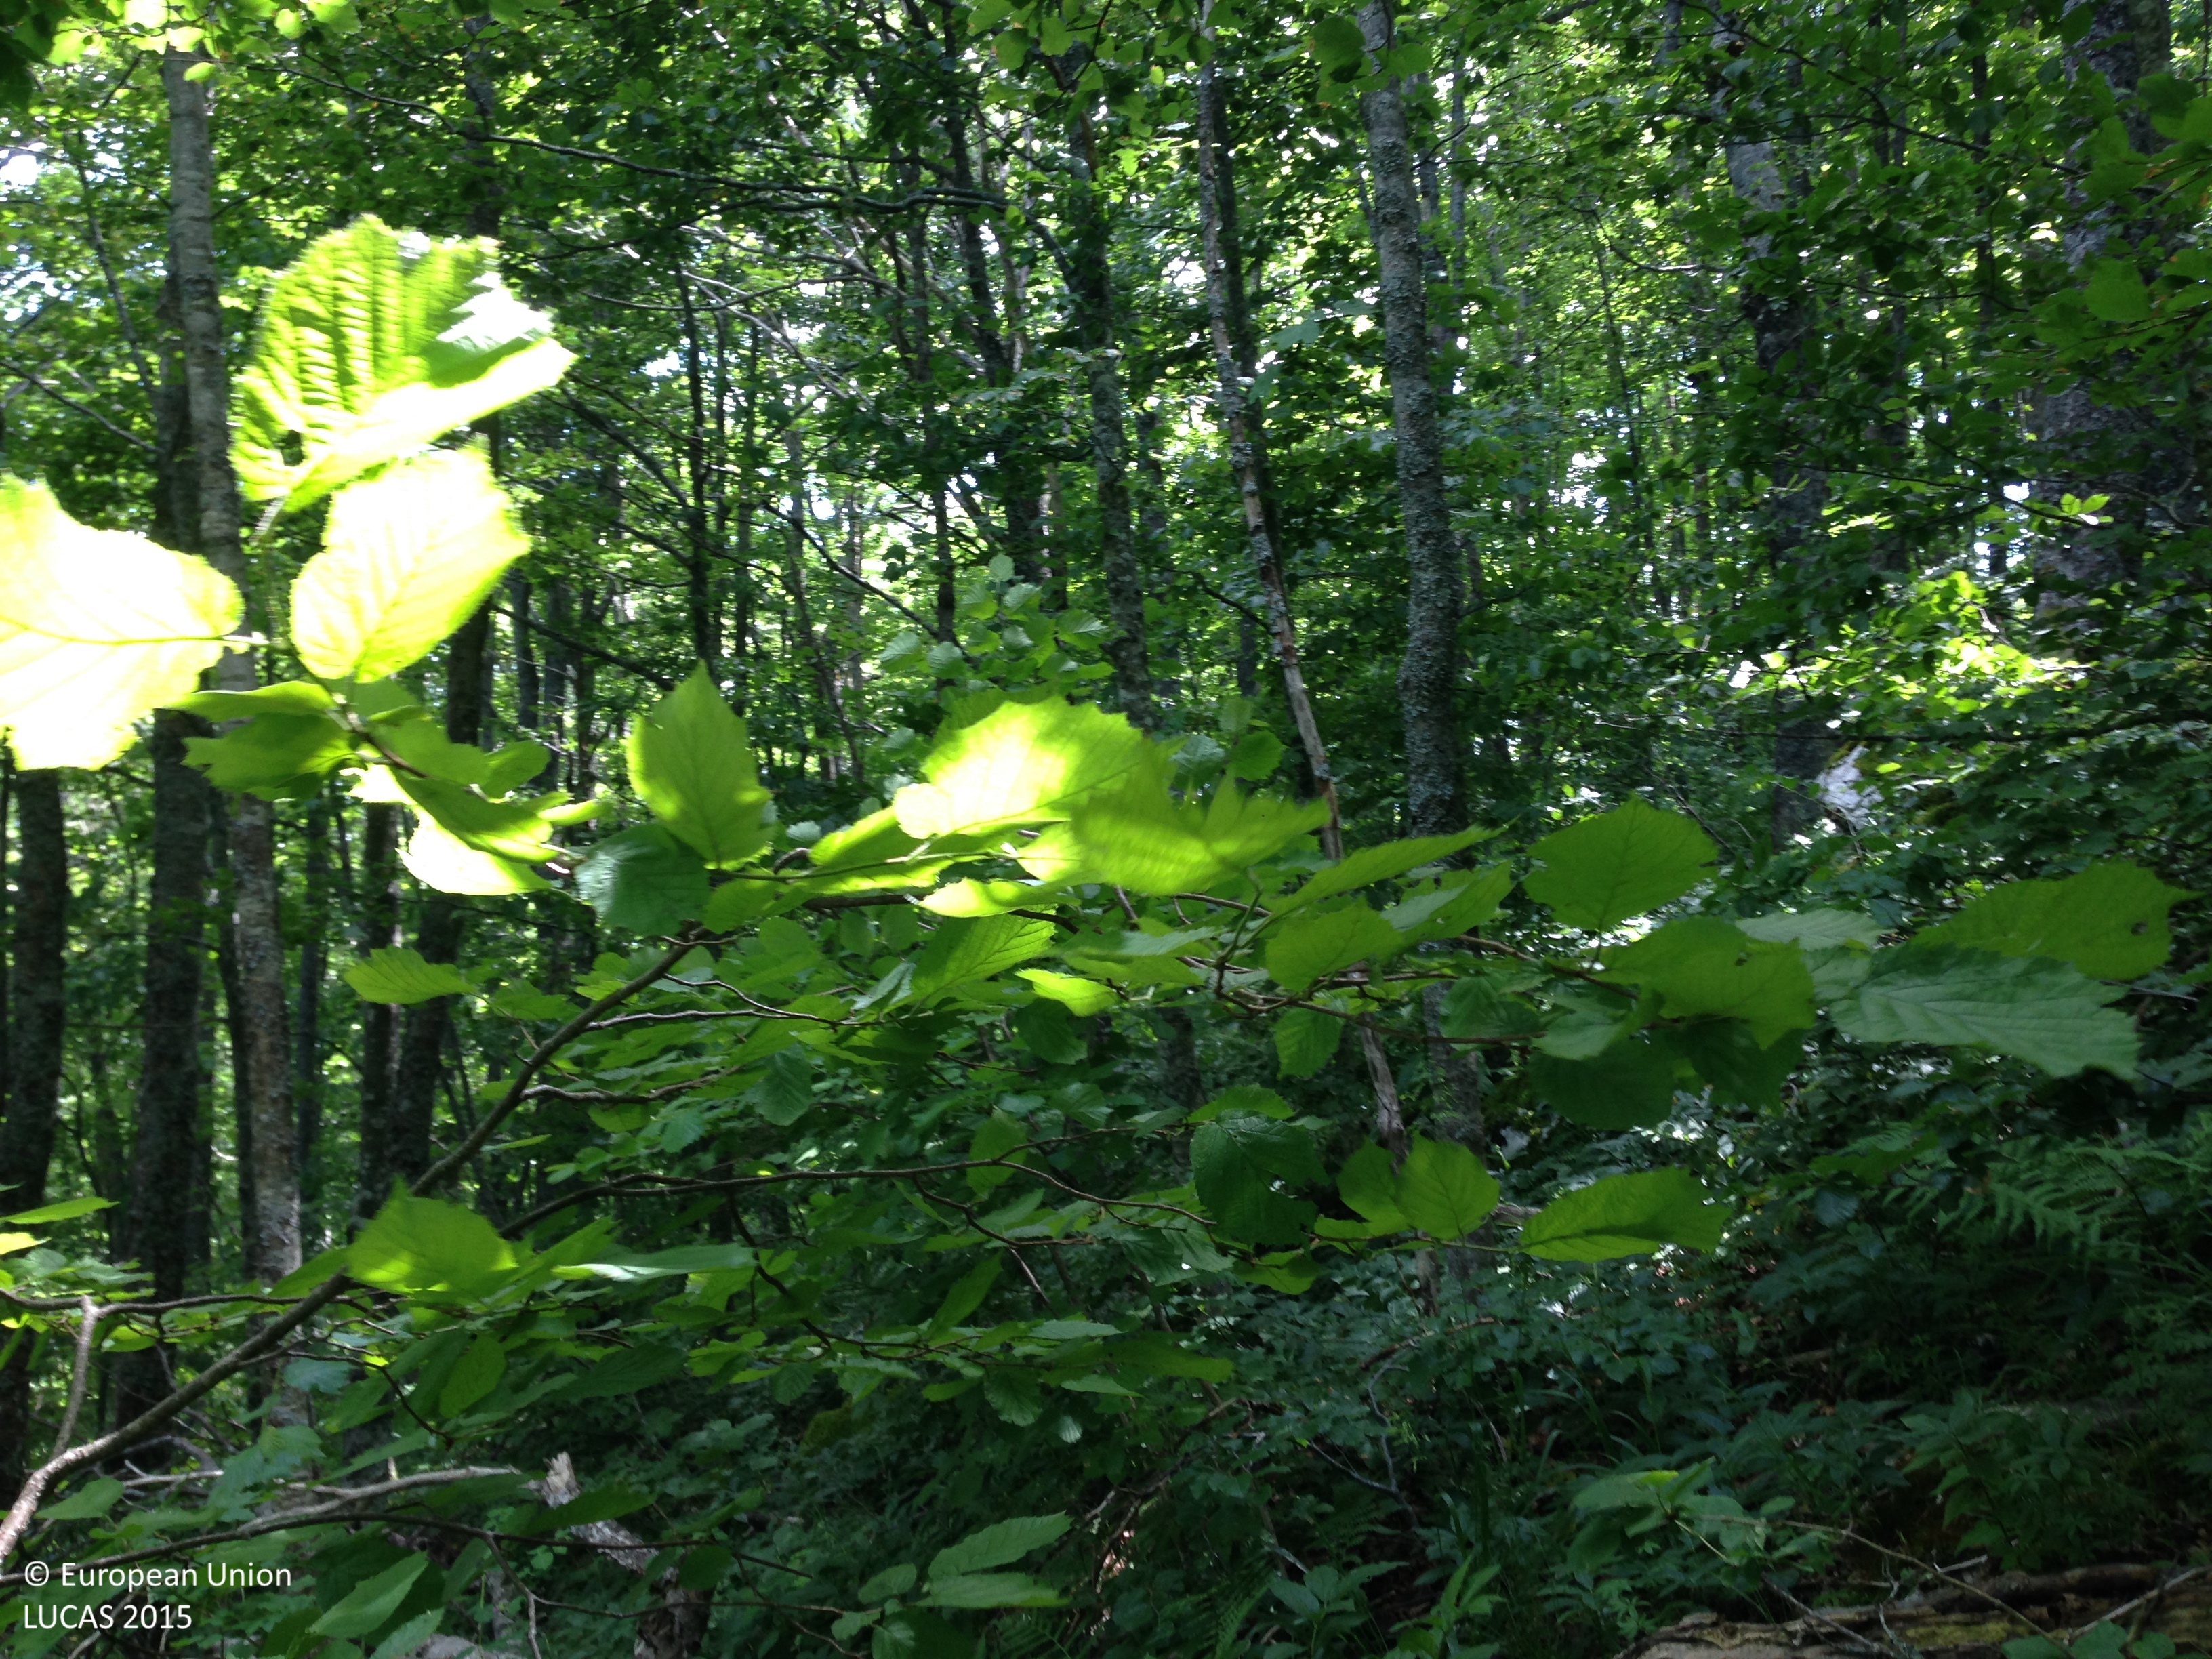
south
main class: Woodland
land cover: Broadleaved woodland
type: thermophilous deciduous forest
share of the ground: > 75 %
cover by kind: broadleaved forest trees 75 %, herbaceous plants 10 %, shrubs 5 %, consolidated bare surface 5 %, unconsolidated bare surface 5 %
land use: Forestry
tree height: > 5 m
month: June
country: HR
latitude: 44.6716
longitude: 15.8850
